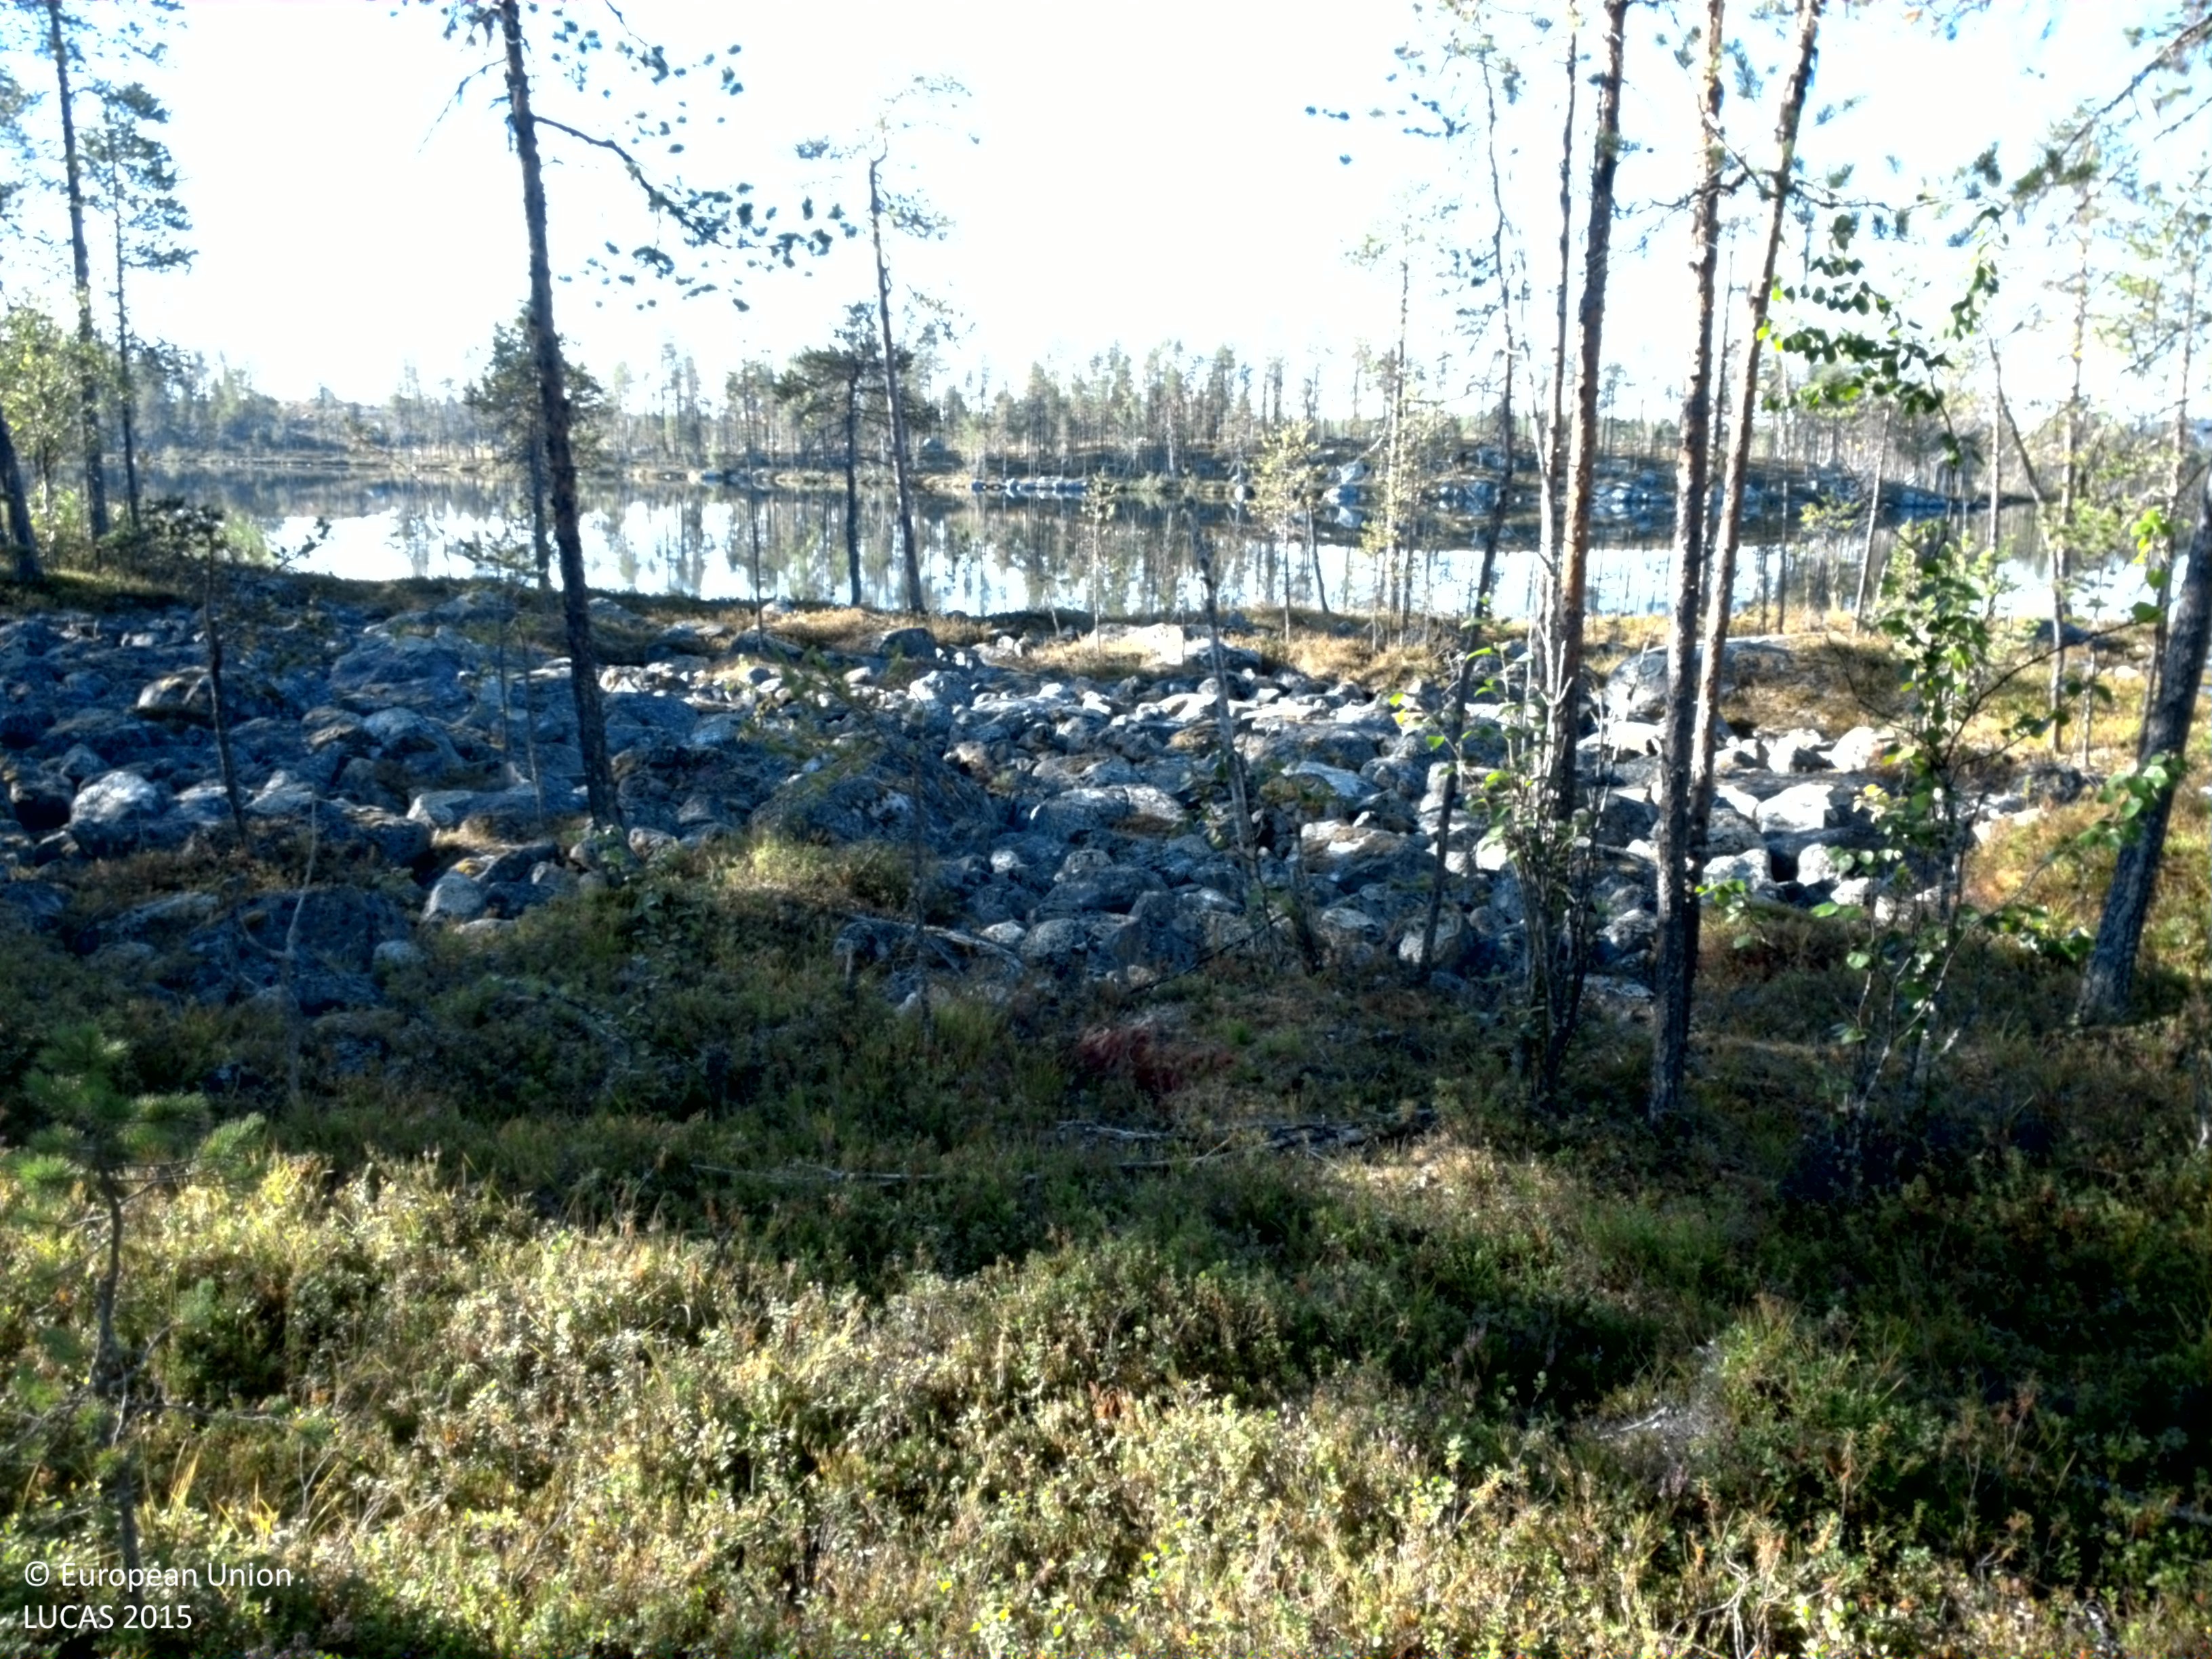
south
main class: Woodland
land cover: Pine dominated coniferous woodland
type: boreal forest
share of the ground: 25 - 50 %
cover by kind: shrubs 60 %, coniferous forest trees 25 %, lichens and mosses 10 %, consolidated bare surface 5 %
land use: Forestry
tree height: > 5 m
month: August
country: SE
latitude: 66.6570
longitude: 19.6537
